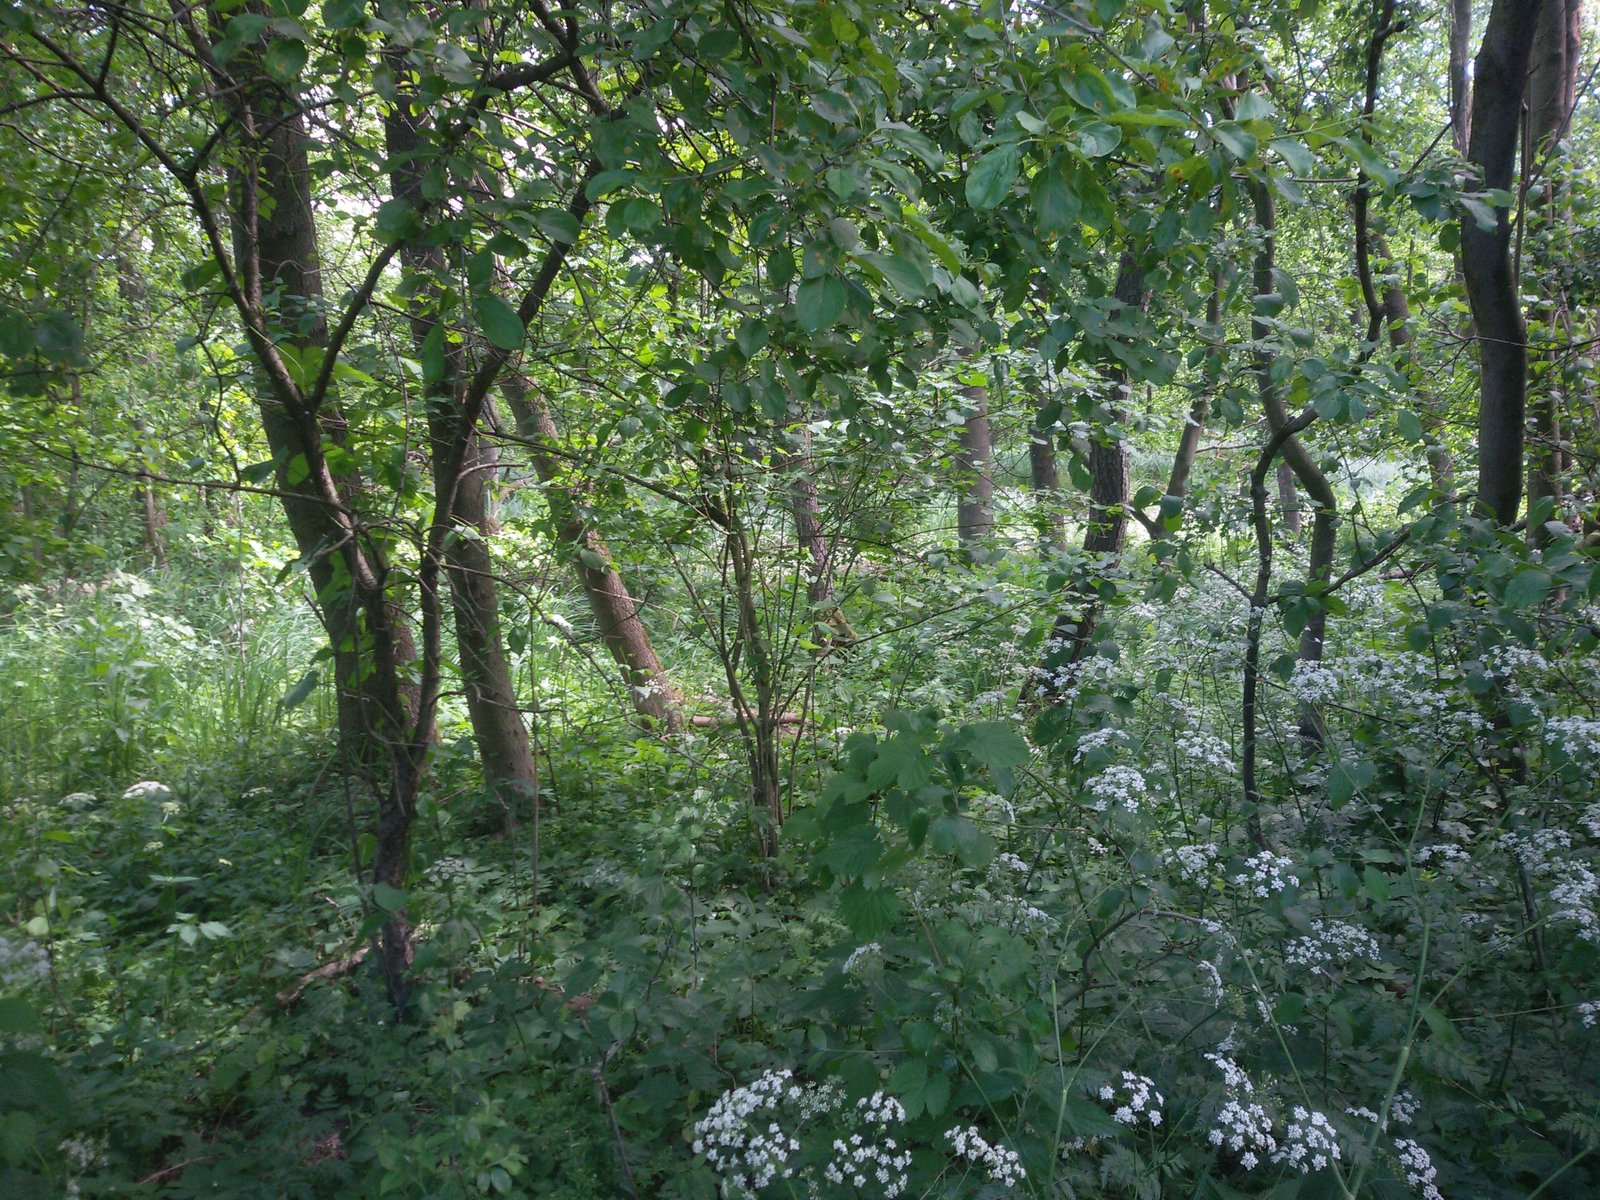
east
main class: Woodland
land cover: Broadleaved woodland
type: mesophytic deciduous forest
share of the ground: > 75 %
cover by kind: broadleaved forest trees 80 %, shrubs 10 %, herbaceous plants 10 %
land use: Semi-natural and natural areas not in use
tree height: > 5 m
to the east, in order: Broadleaved woodland; Inland fresh water bodies; Broadleaved woodland; Grassland without tree/shrub cover; Rivers and streams; Spontaneously vegetated surfaces
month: June
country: PL
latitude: 52.1019
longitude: 16.9442
